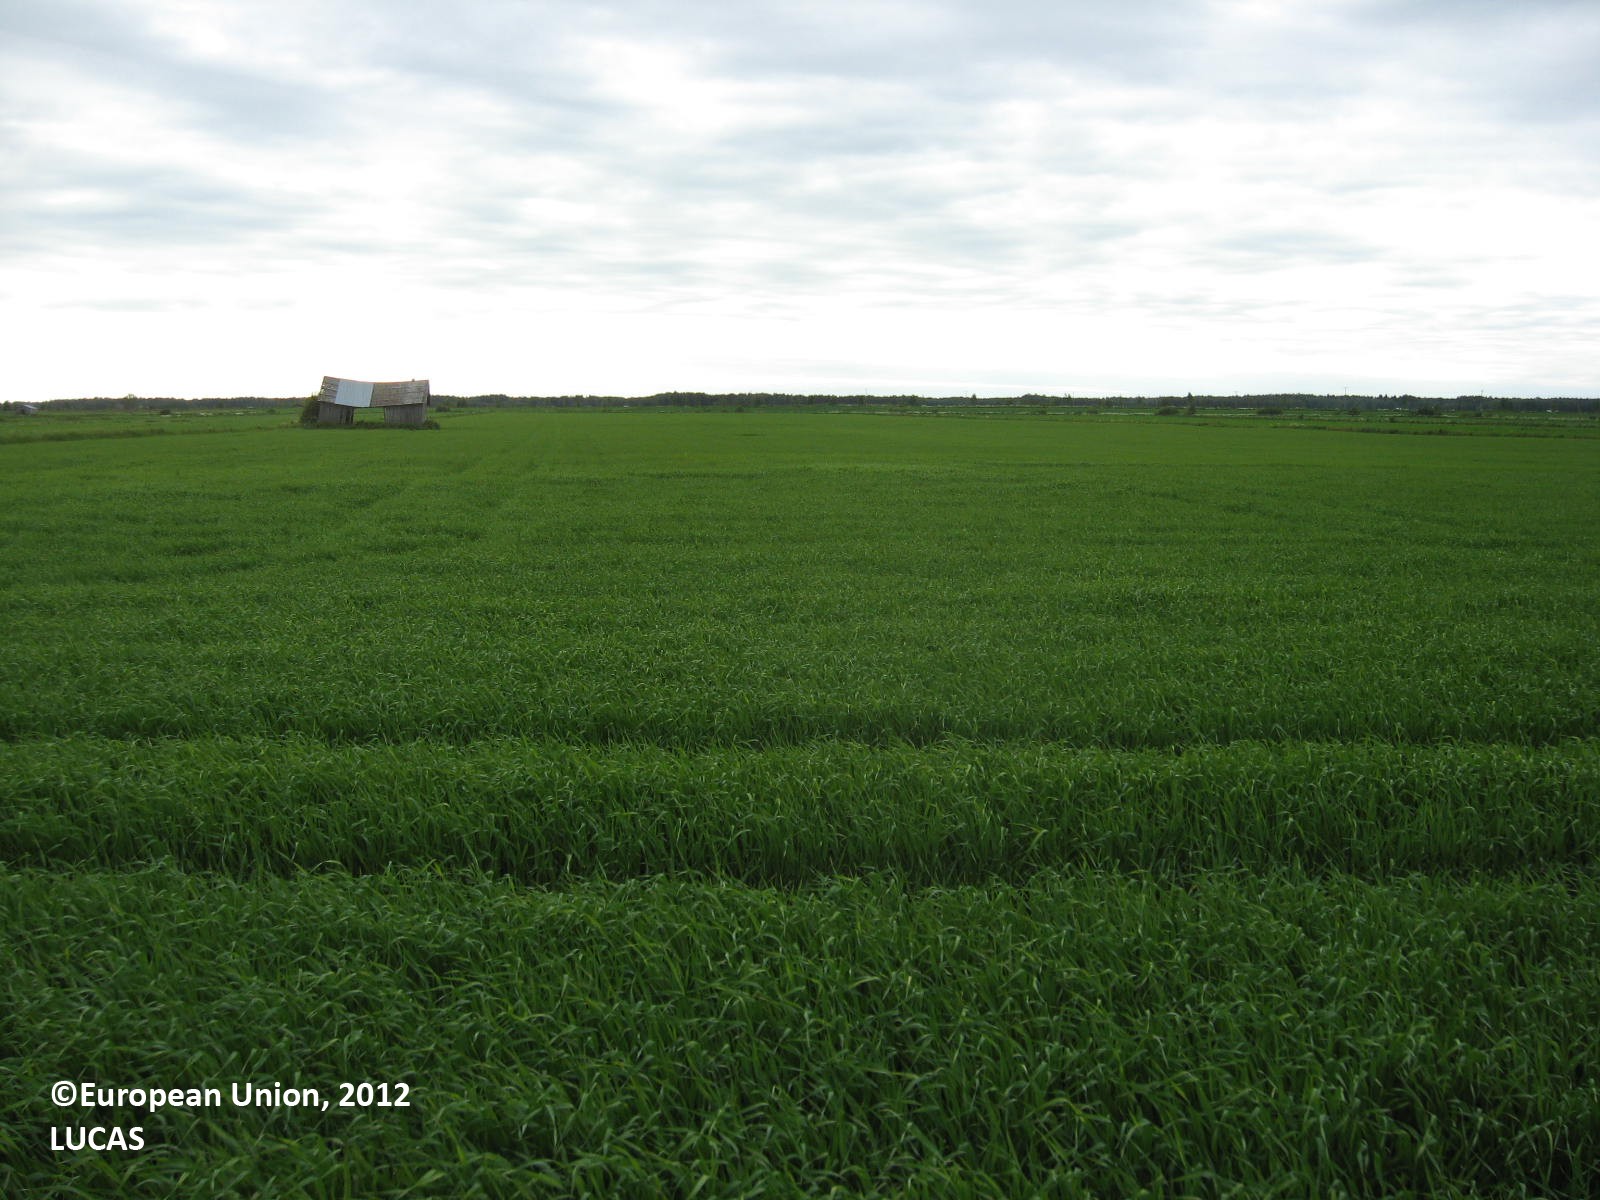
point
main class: Cropland
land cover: Barley
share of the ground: > 75 %
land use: Agriculture (excluding fallow land and kitchen gardens)
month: June
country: FI
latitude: 62.8681
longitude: 22.8132
